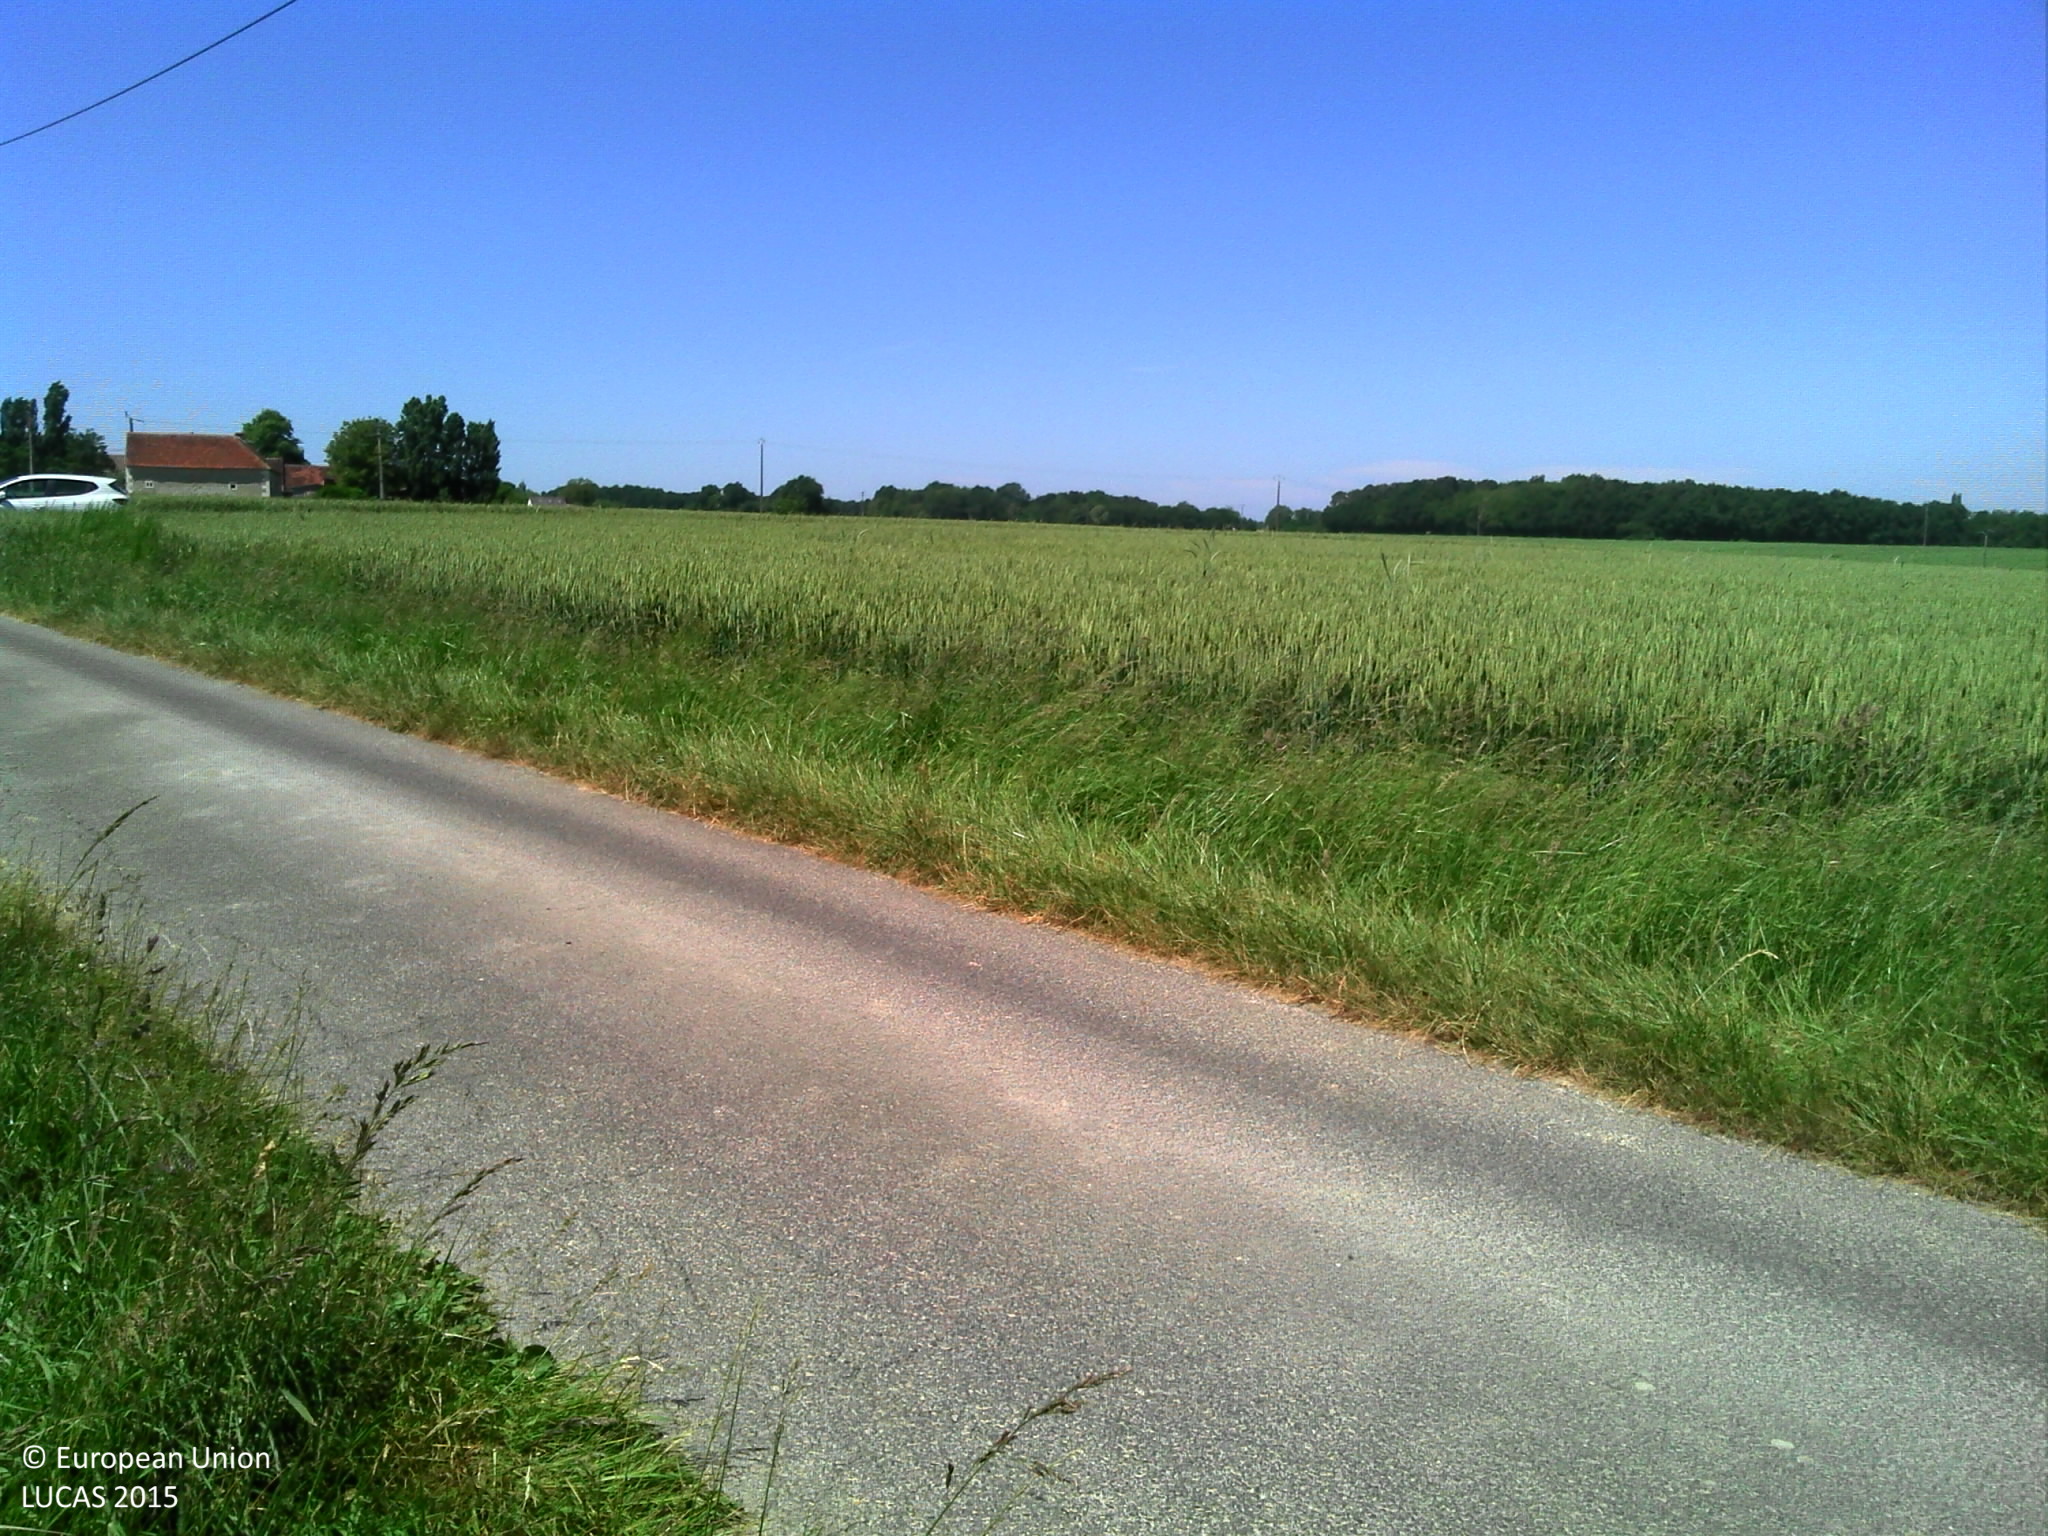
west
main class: Cropland
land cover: Common wheat
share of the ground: > 75 %
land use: Agriculture (excluding fallow land and kitchen gardens)
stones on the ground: < 10 %
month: June
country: FR
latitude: 47.1304
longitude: 1.2187
